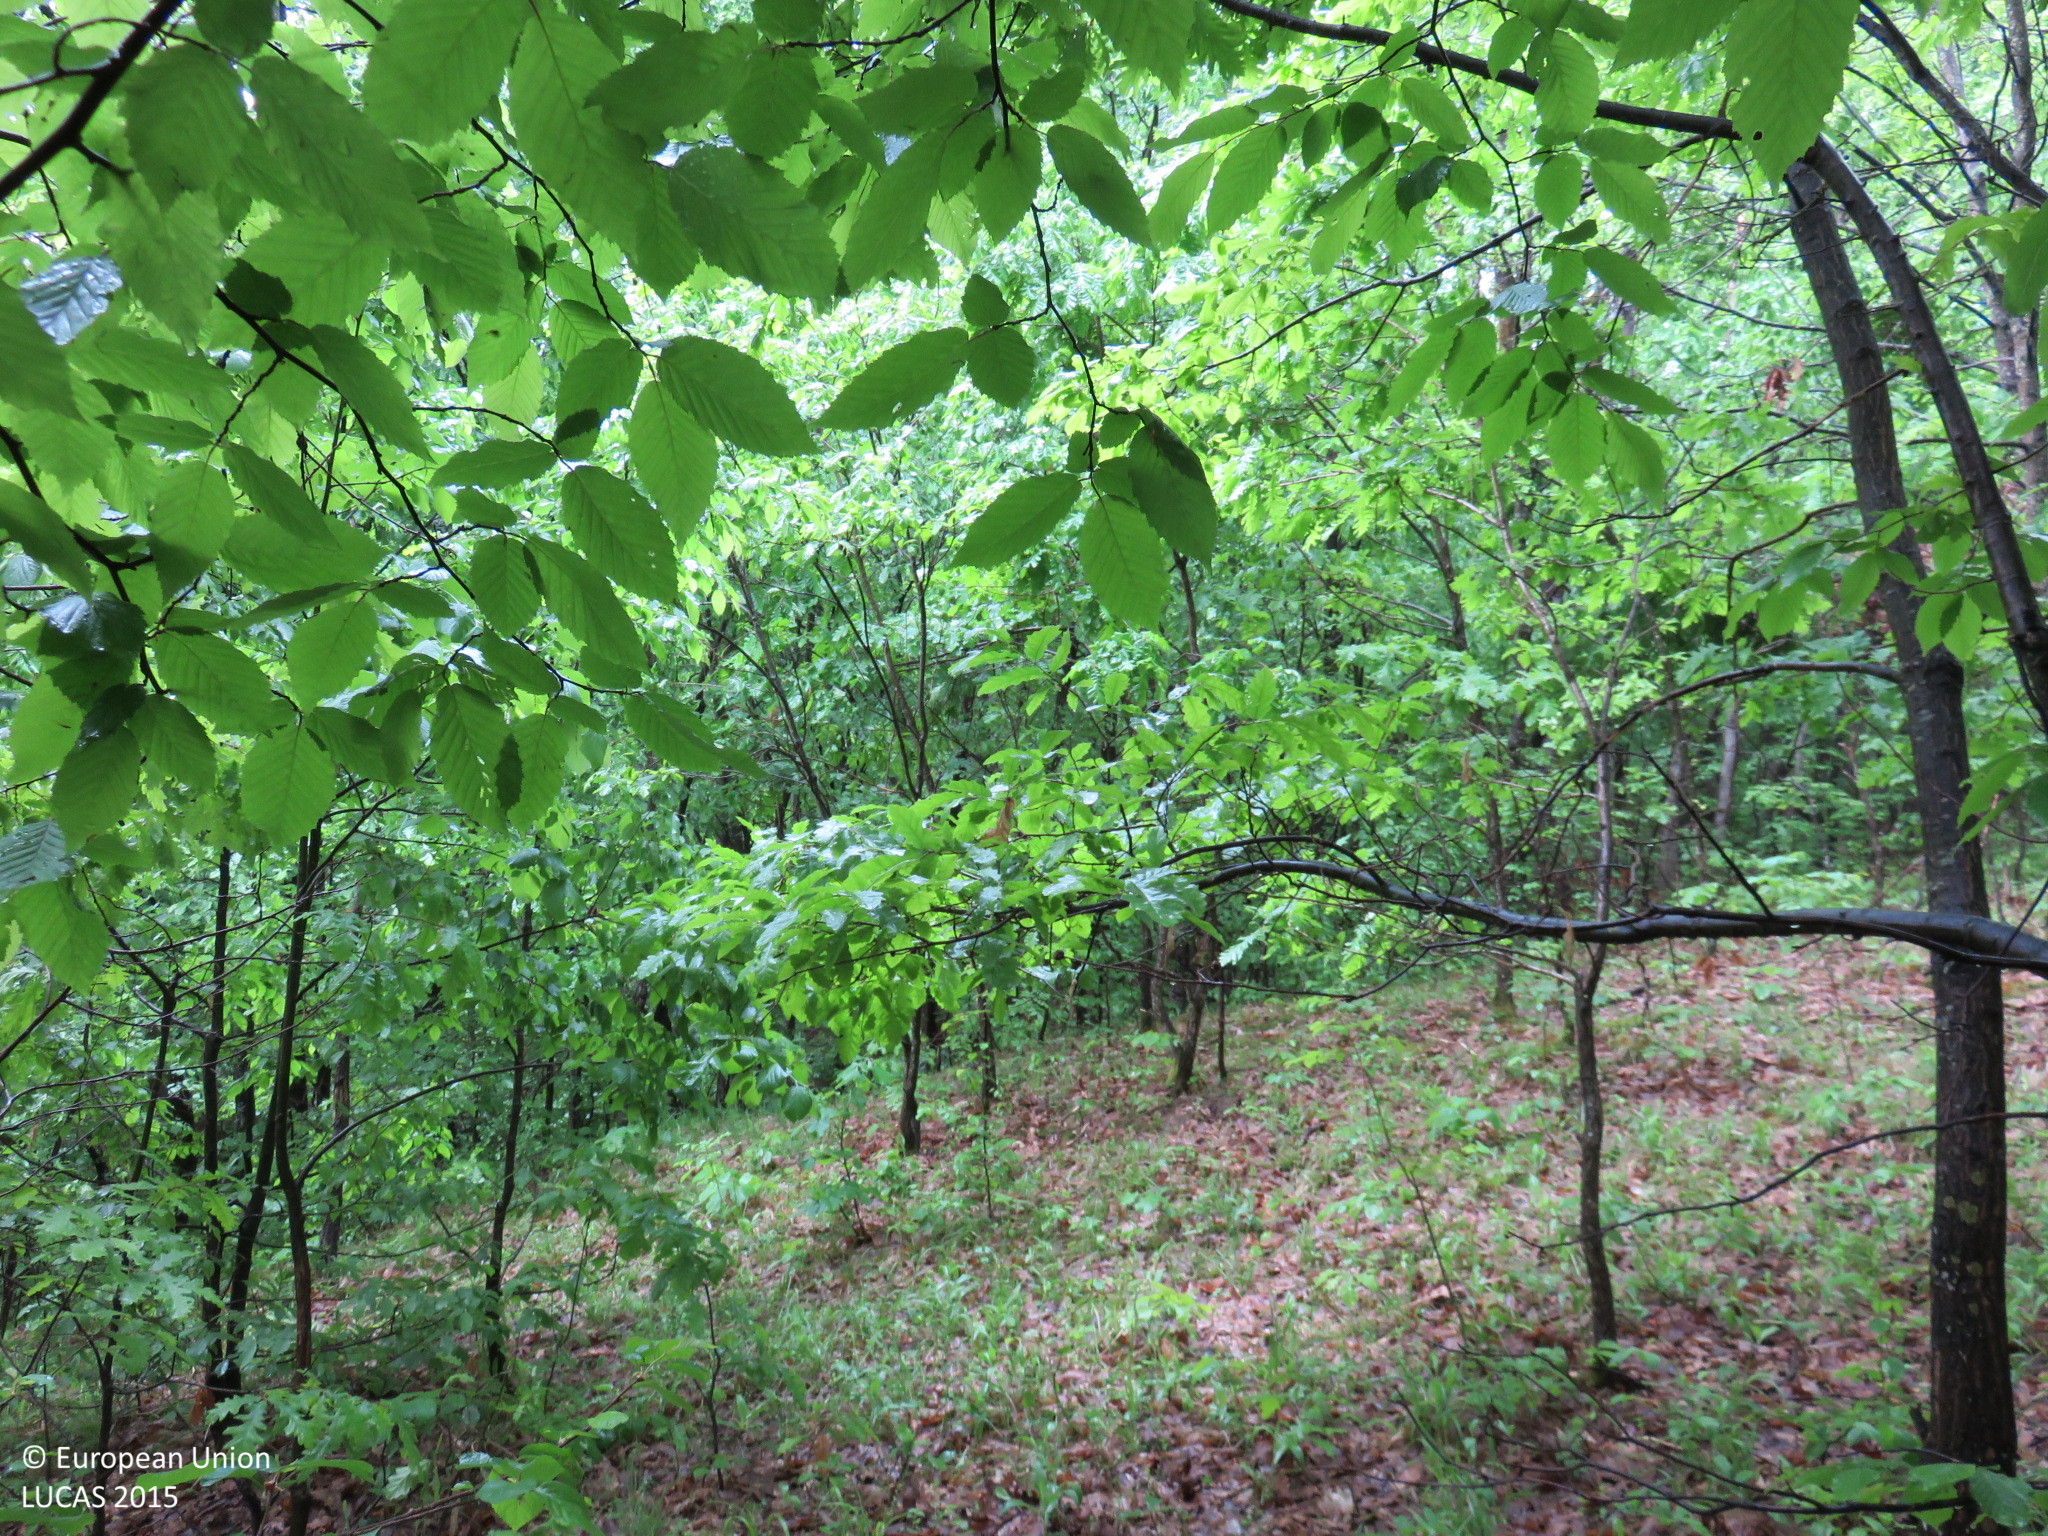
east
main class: Woodland
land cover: Broadleaved woodland
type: mesophytic deciduous forest
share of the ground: > 75 %
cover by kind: broadleaved forest trees 95 %, shrubs 5 %
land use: Forestry
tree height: < 5 m
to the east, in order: Broadleaved woodland; Rivers and streams; Broadleaved woodland; Shrubland with sparse tree cover; Rivers and streams; Broadleaved woodland
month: May
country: BG
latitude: 42.8810
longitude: 24.7890
